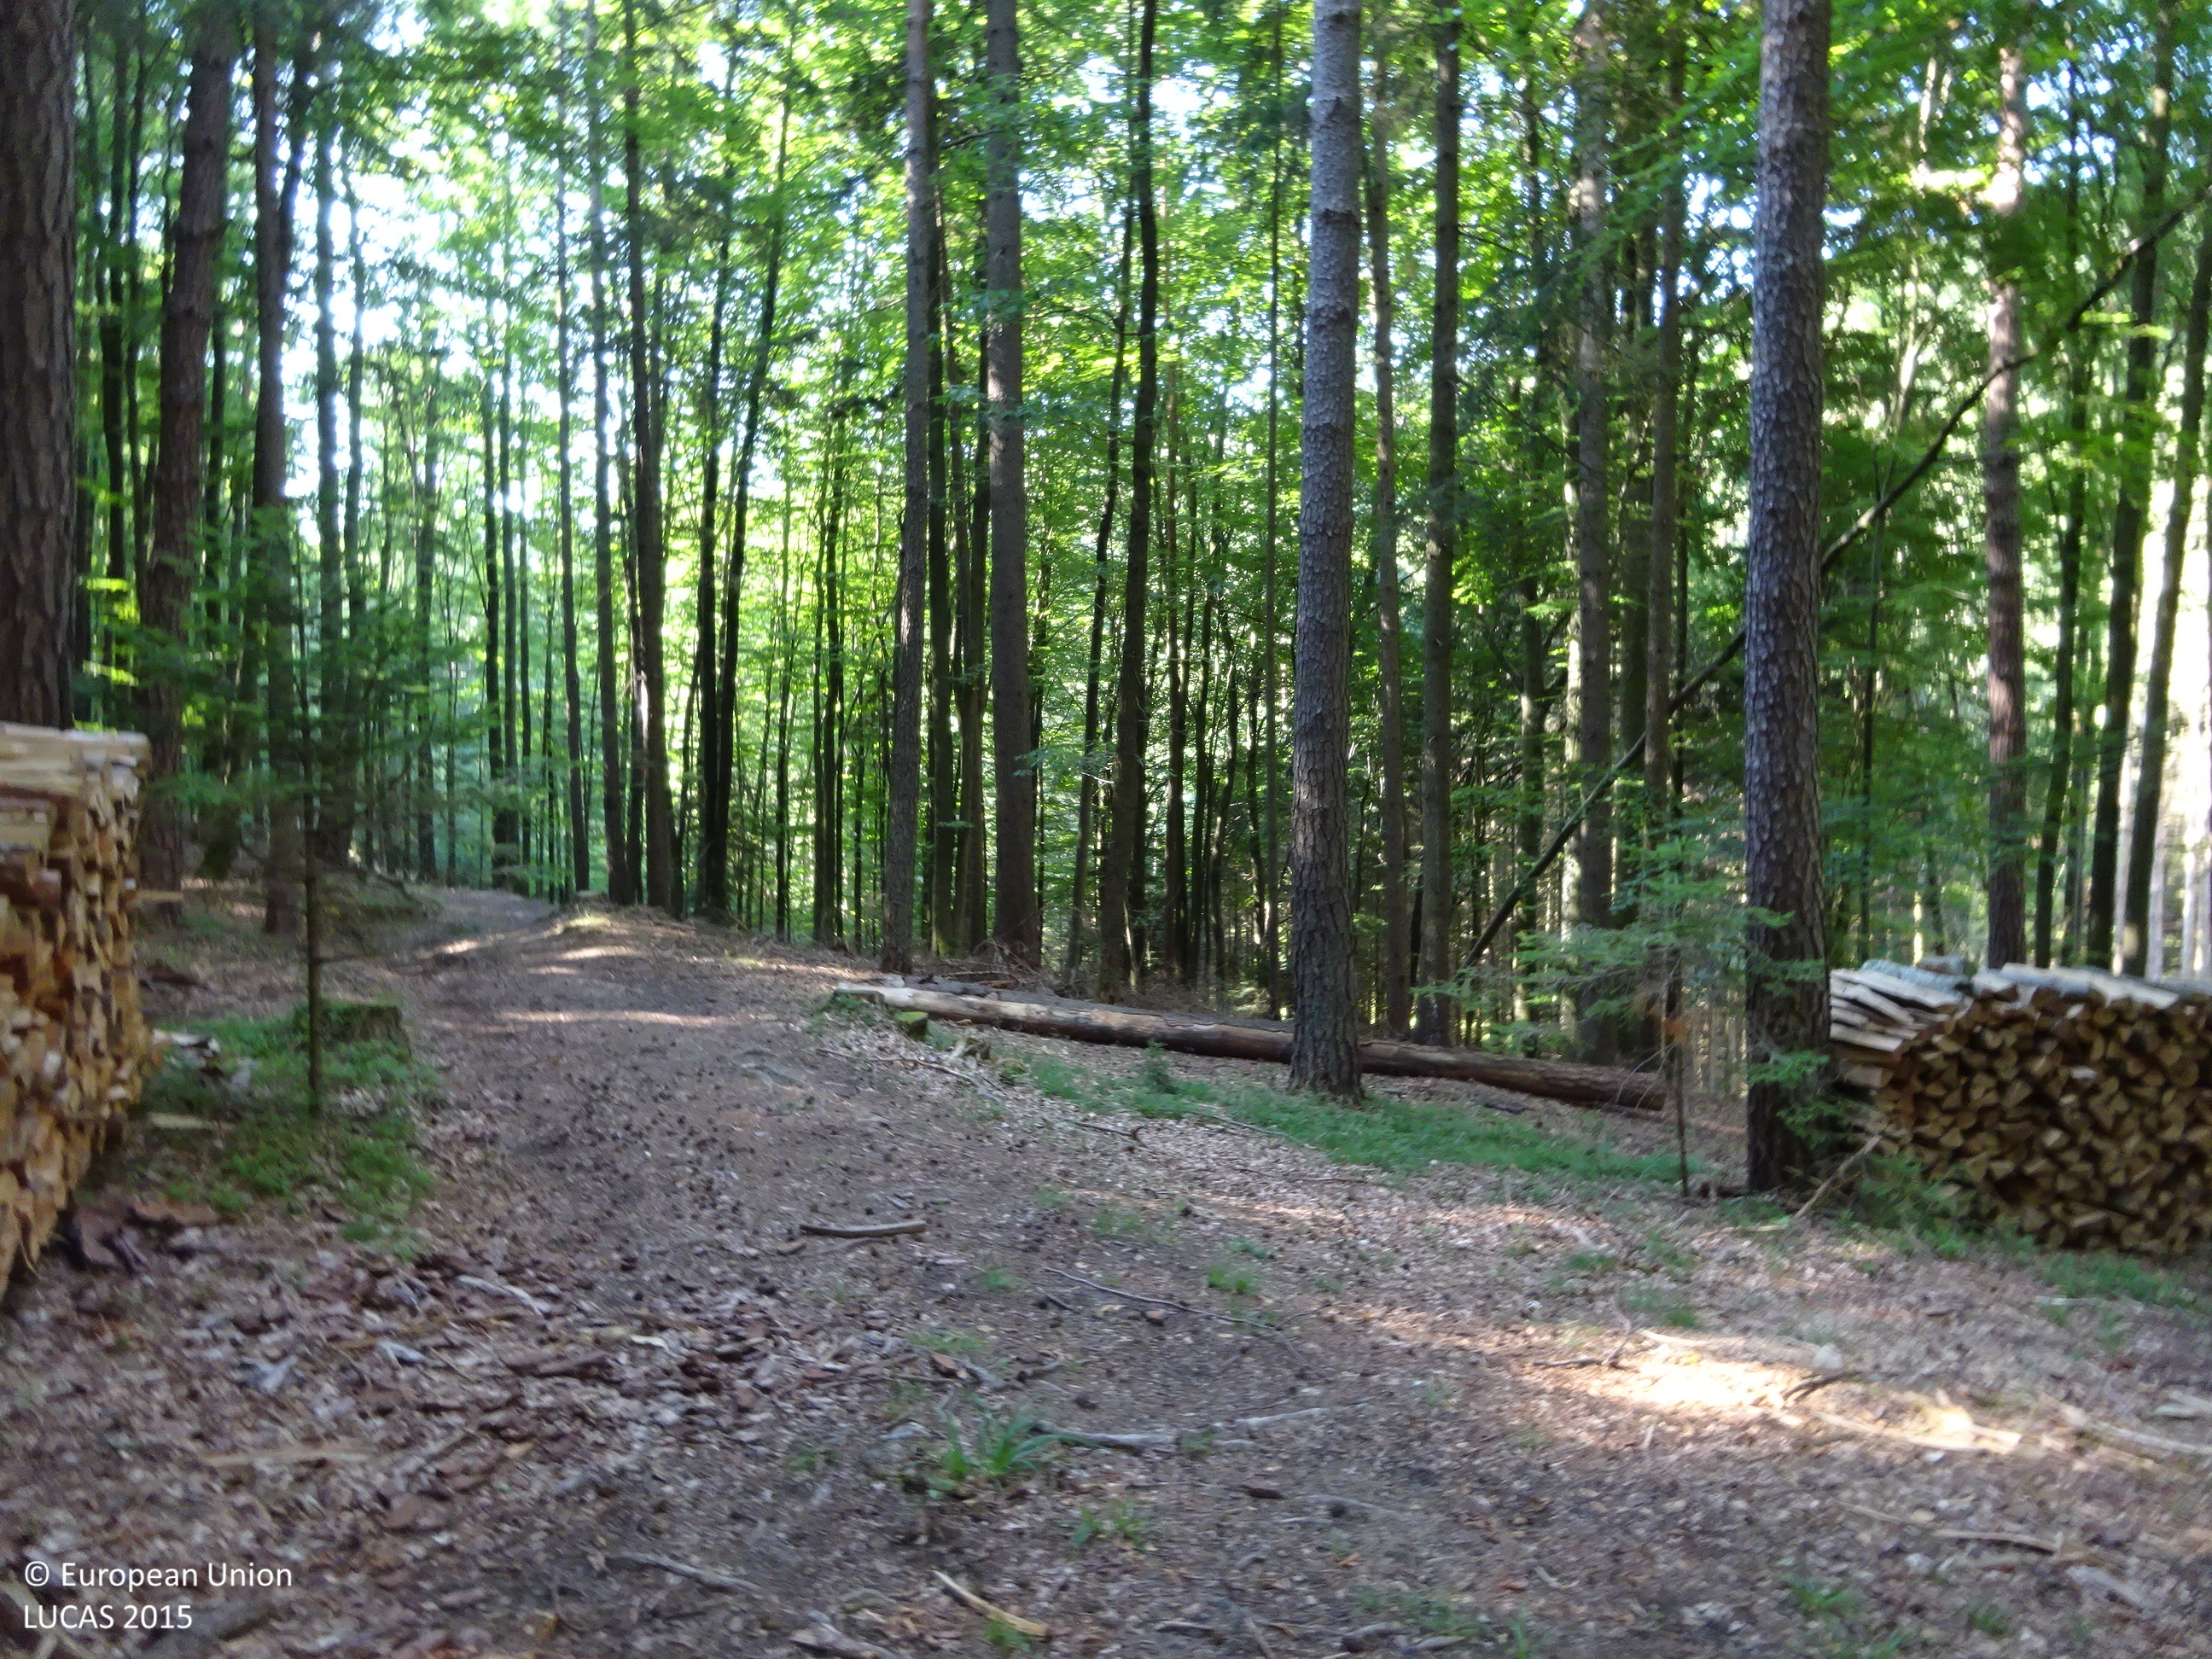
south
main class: Woodland
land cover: Pine dominated mixed woodland
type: hemiboreal forest and nemoral coniferous forest and mixed broadleaved-coniferous forest
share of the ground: > 75 %
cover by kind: broadleaved forest trees 75 %, coniferous forest trees 25 %
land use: Forestry
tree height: > 5 m
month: August
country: AT
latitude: 47.4207
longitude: 16.1396
